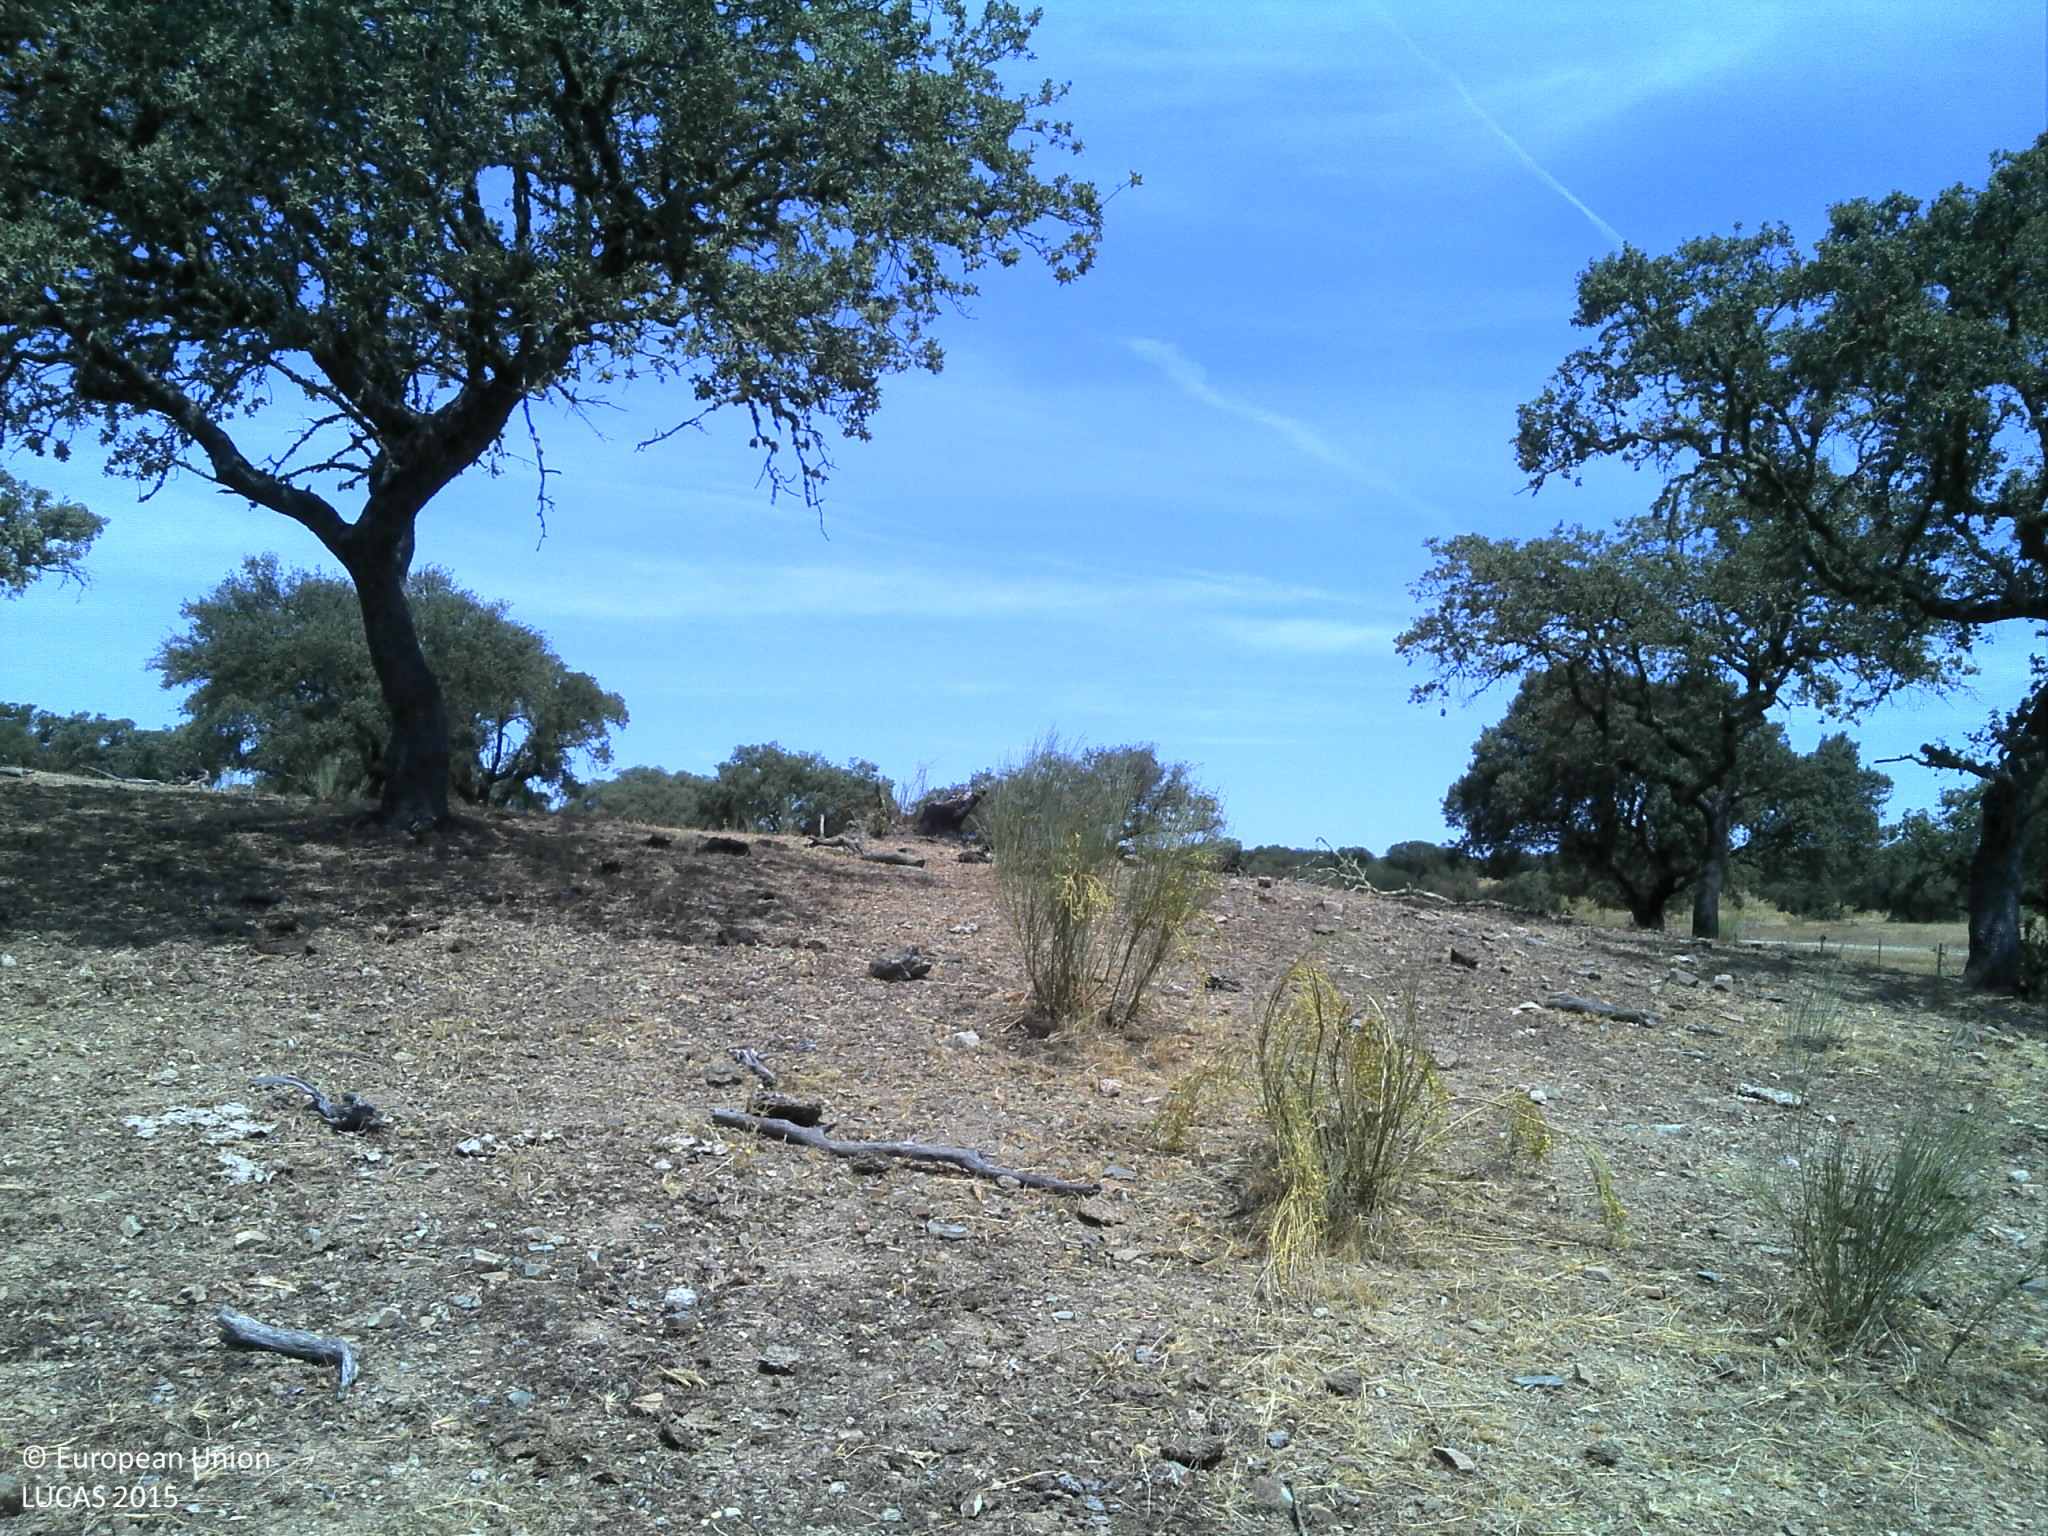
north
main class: Woodland
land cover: Broadleaved woodland
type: broadleaved evergreen forest
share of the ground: 10 - 25 %
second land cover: Grassland without tree/shrub cover
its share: 10 - 25 %
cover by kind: unconsolidated bare surface 75 %, broadleaved forest trees 10 %, herbaceous plants 10 %, shrubs 5 %
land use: Forestry
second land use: Agriculture (excluding fallow land and kitchen gardens)
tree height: > 5 m
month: July
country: PT
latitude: 38.3215
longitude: -7.4443
